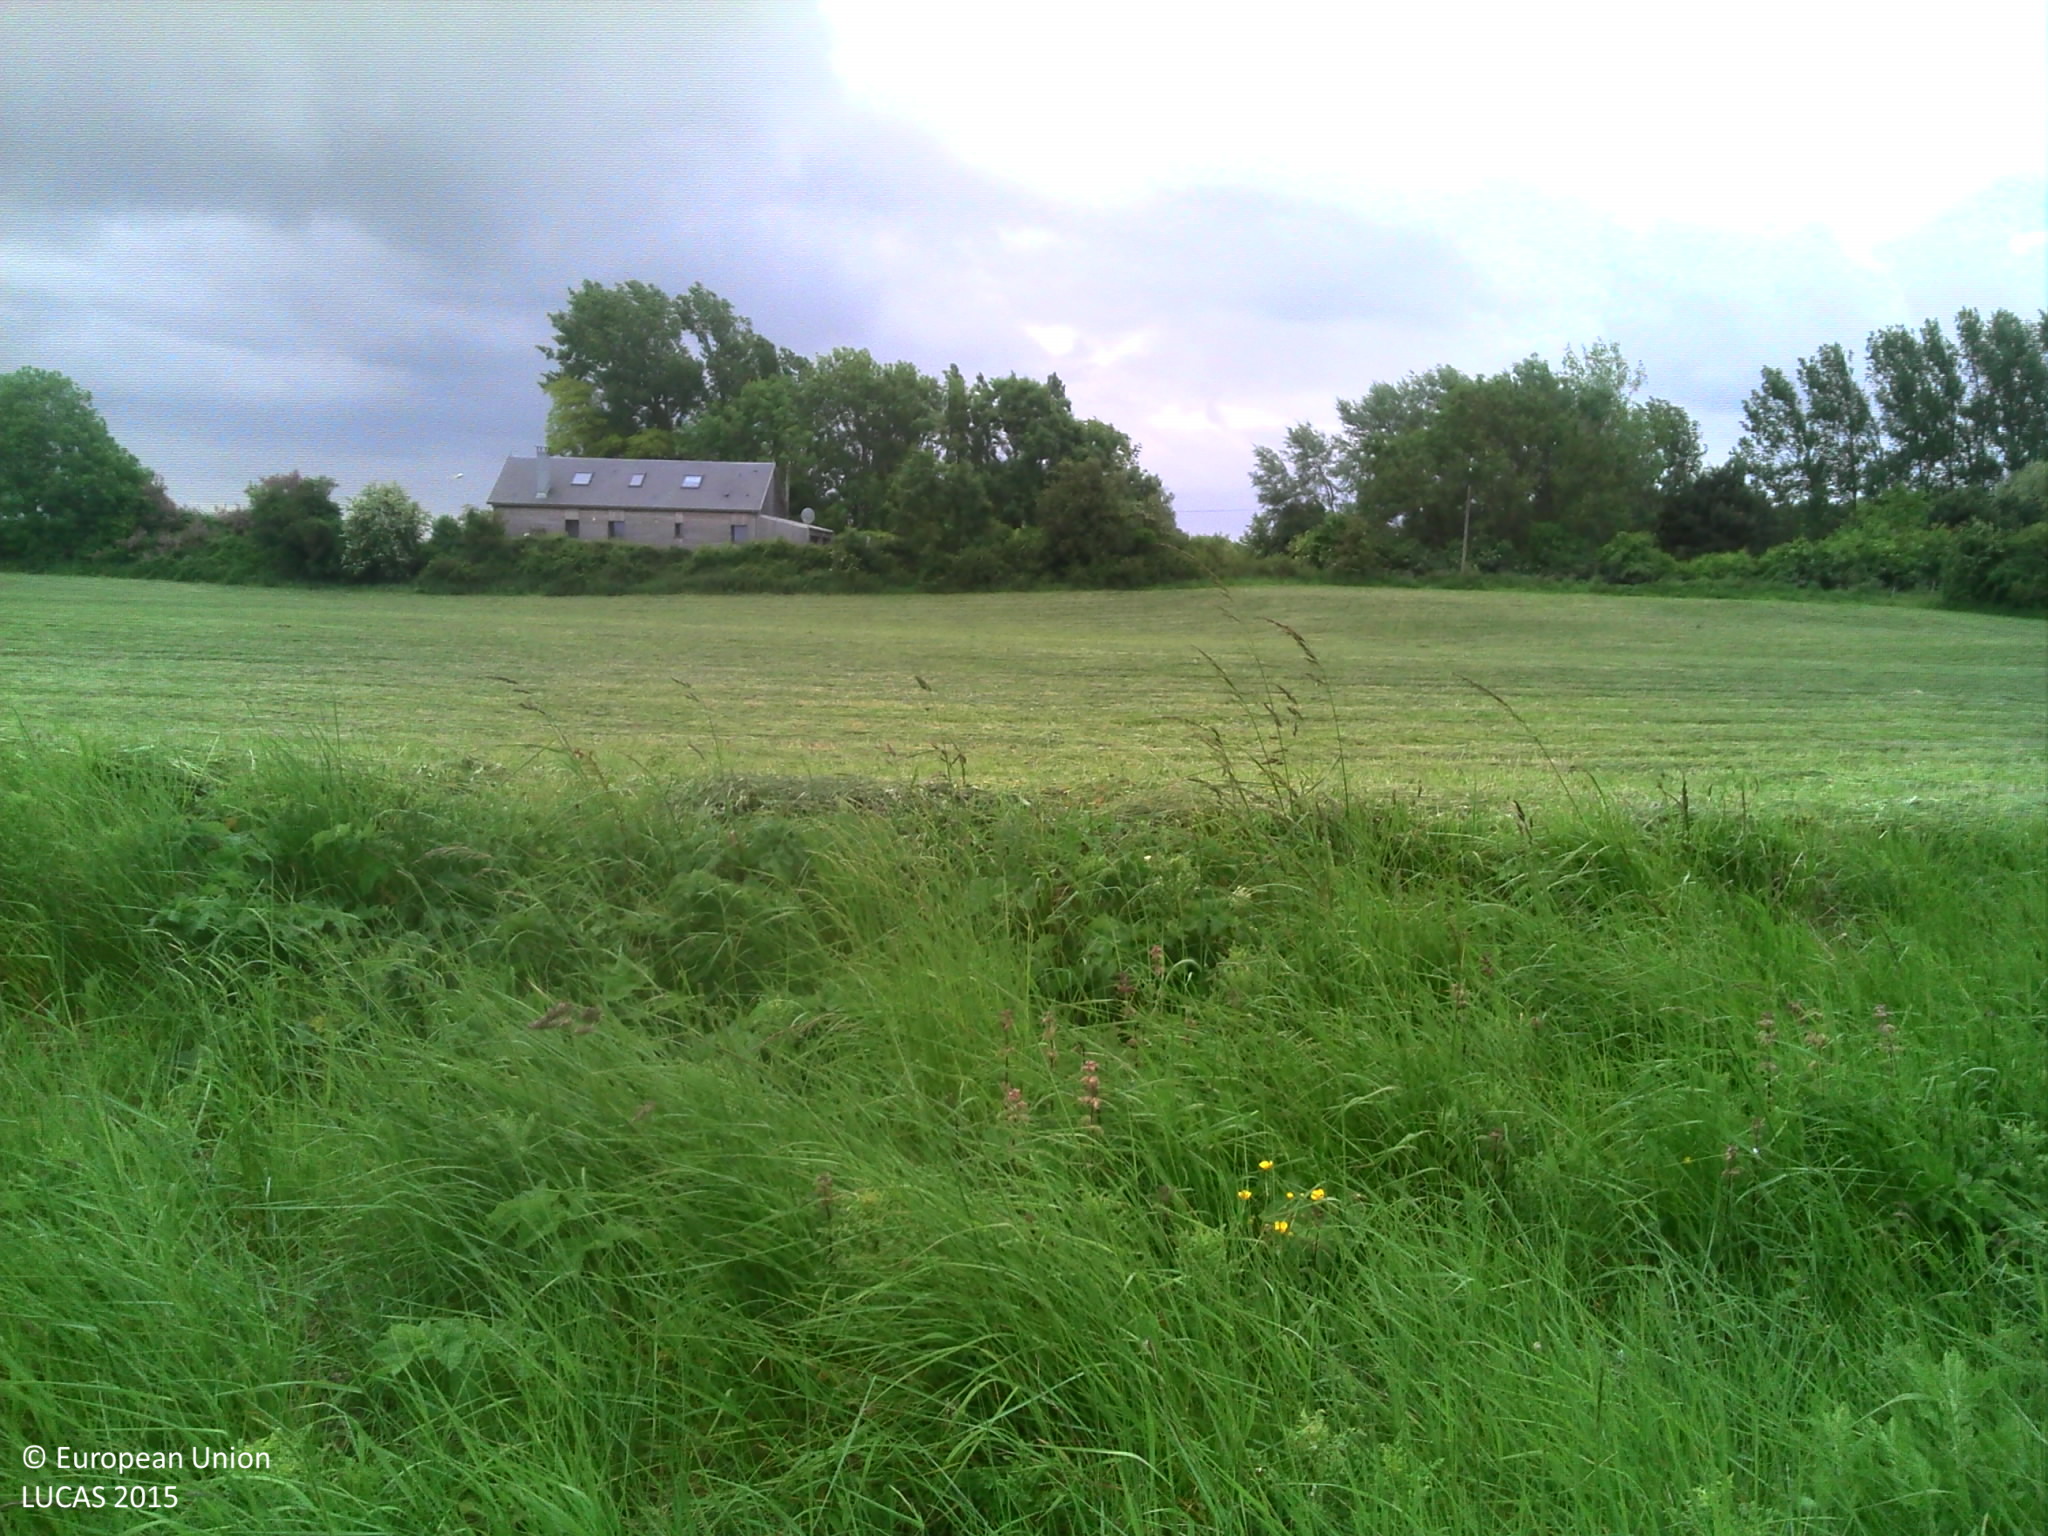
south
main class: Grassland
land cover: Grassland without tree/shrub cover
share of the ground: > 75 %
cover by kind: herbaceous plants 100 %
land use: Agriculture (excluding fallow land and kitchen gardens)
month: May
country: FR
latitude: 50.2144
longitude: 1.5591
